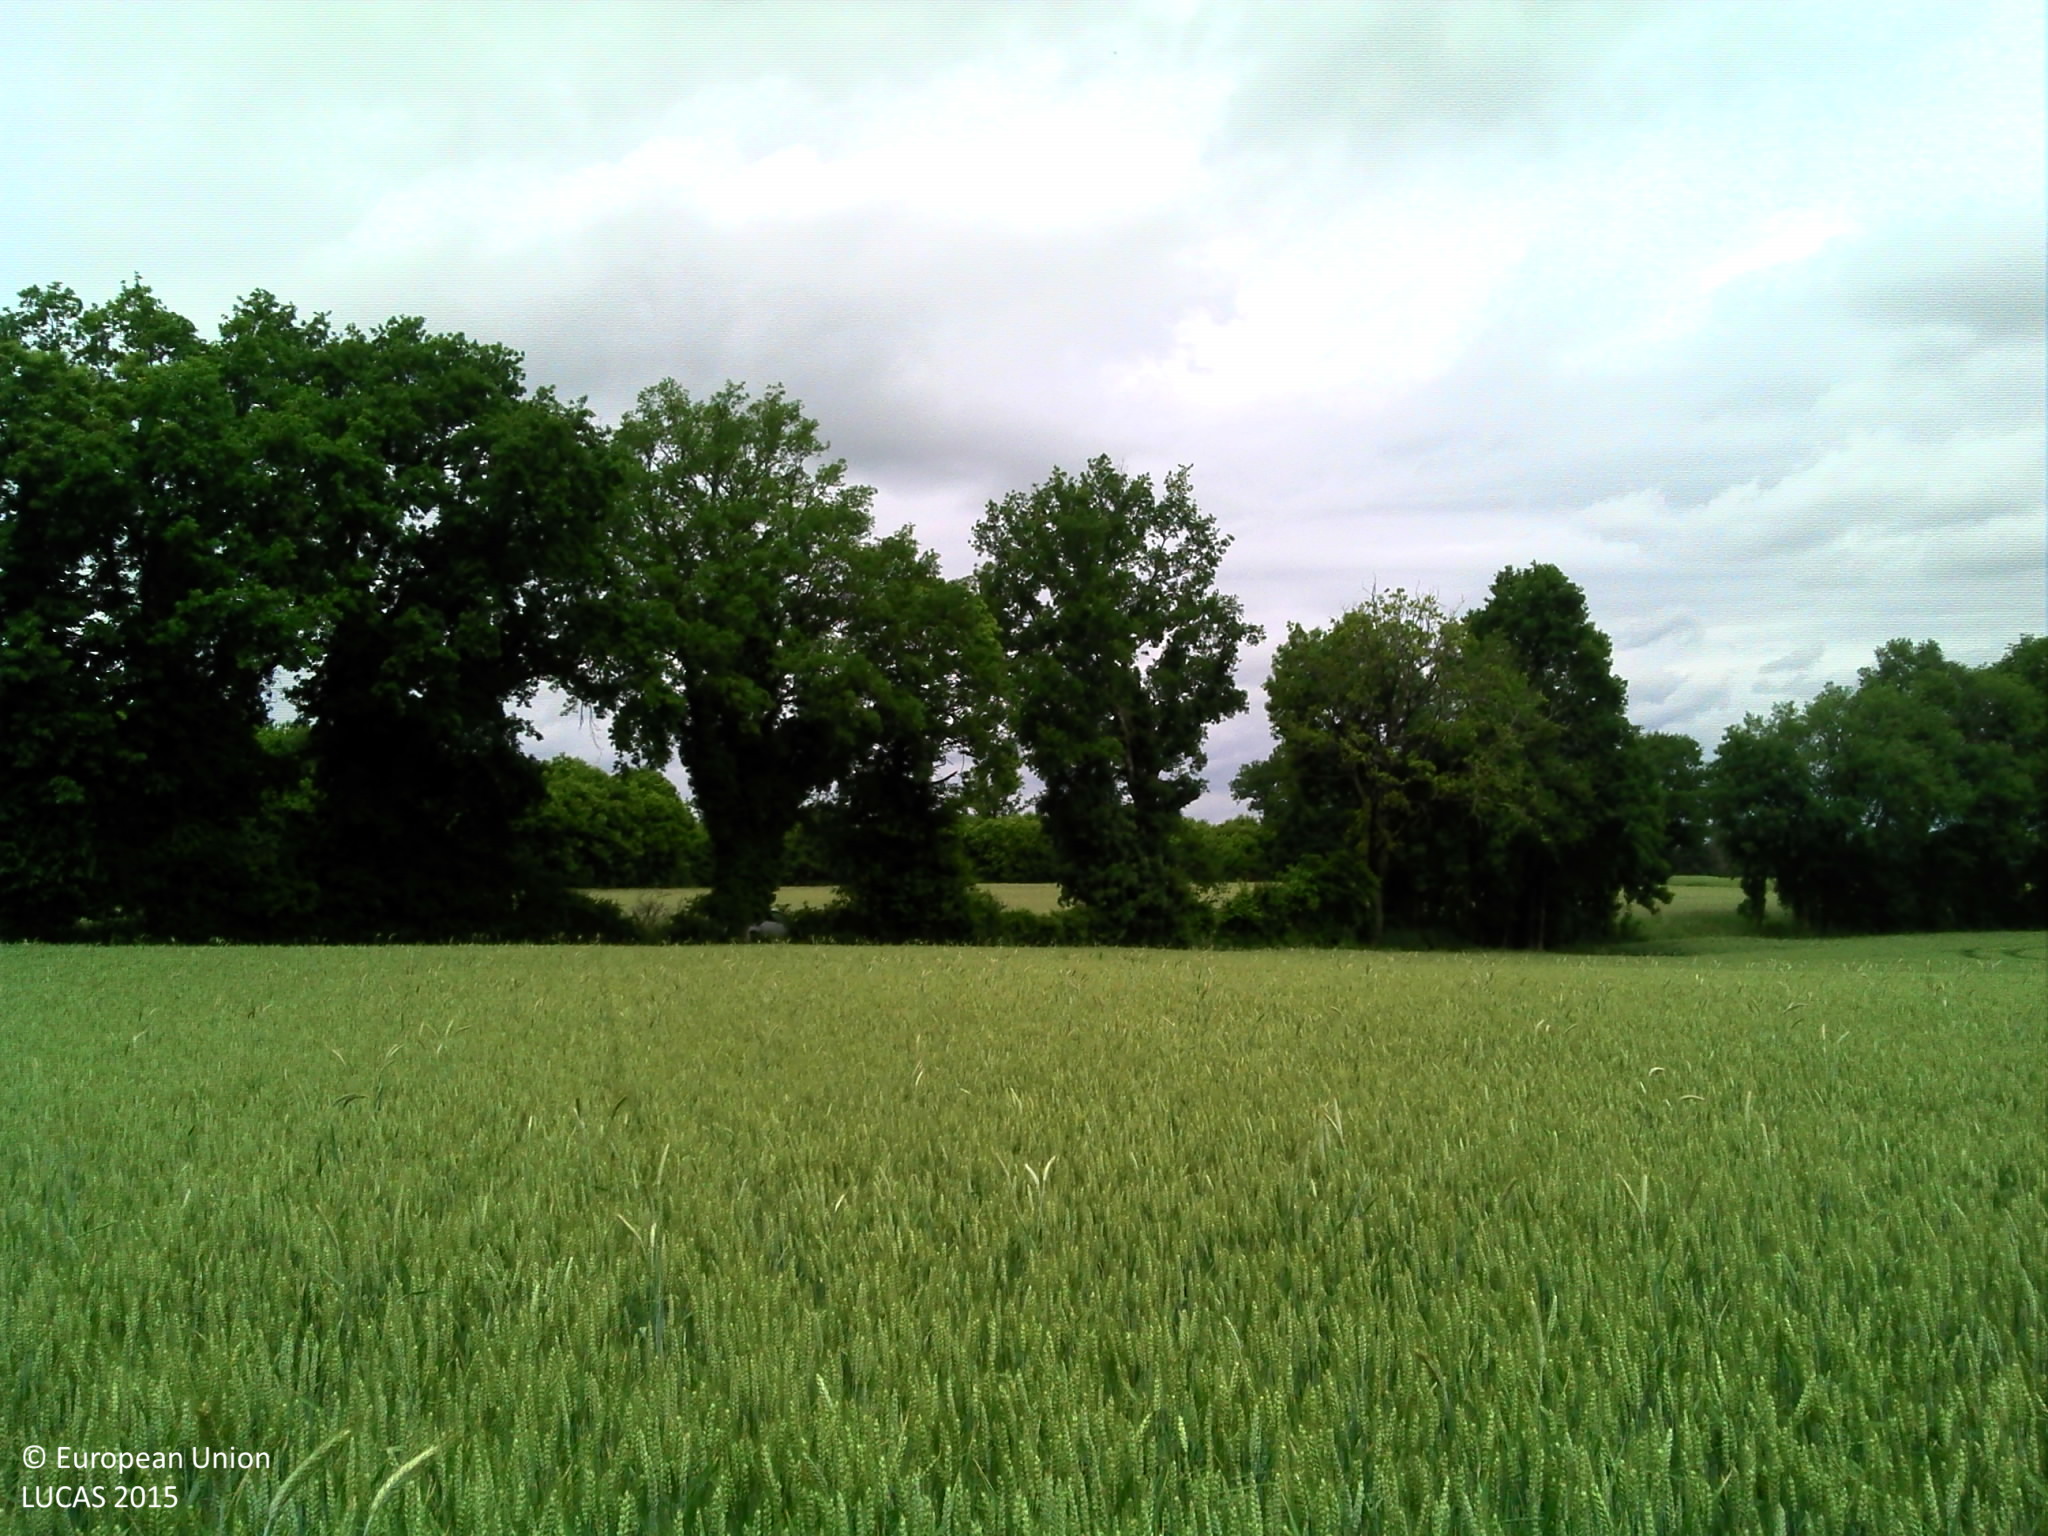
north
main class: Cropland
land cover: Common wheat
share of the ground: > 75 %
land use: Agriculture (excluding fallow land and kitchen gardens)
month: June
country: FR
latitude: 46.0058
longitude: 0.3628
